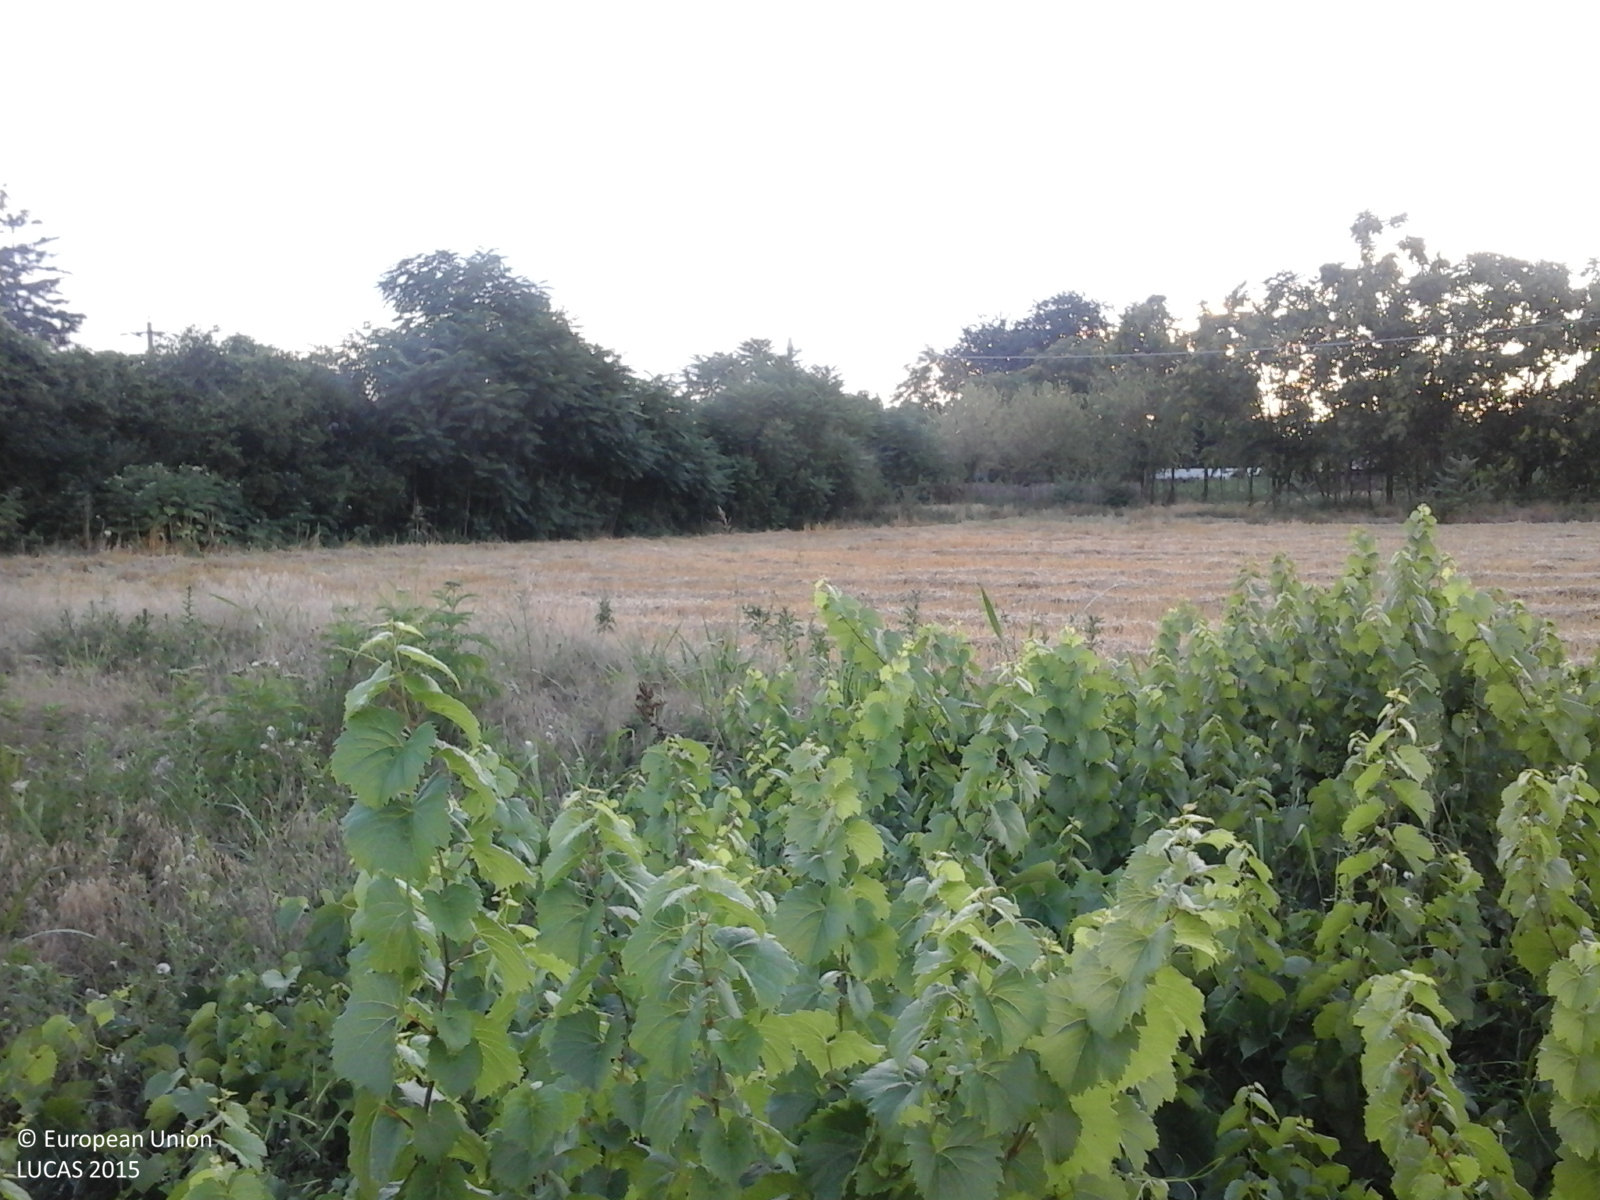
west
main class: Cropland
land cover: Vineyards
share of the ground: > 75 %
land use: Agriculture (excluding fallow land and kitchen gardens)
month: July
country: RO
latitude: 43.9190
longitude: 25.9245
